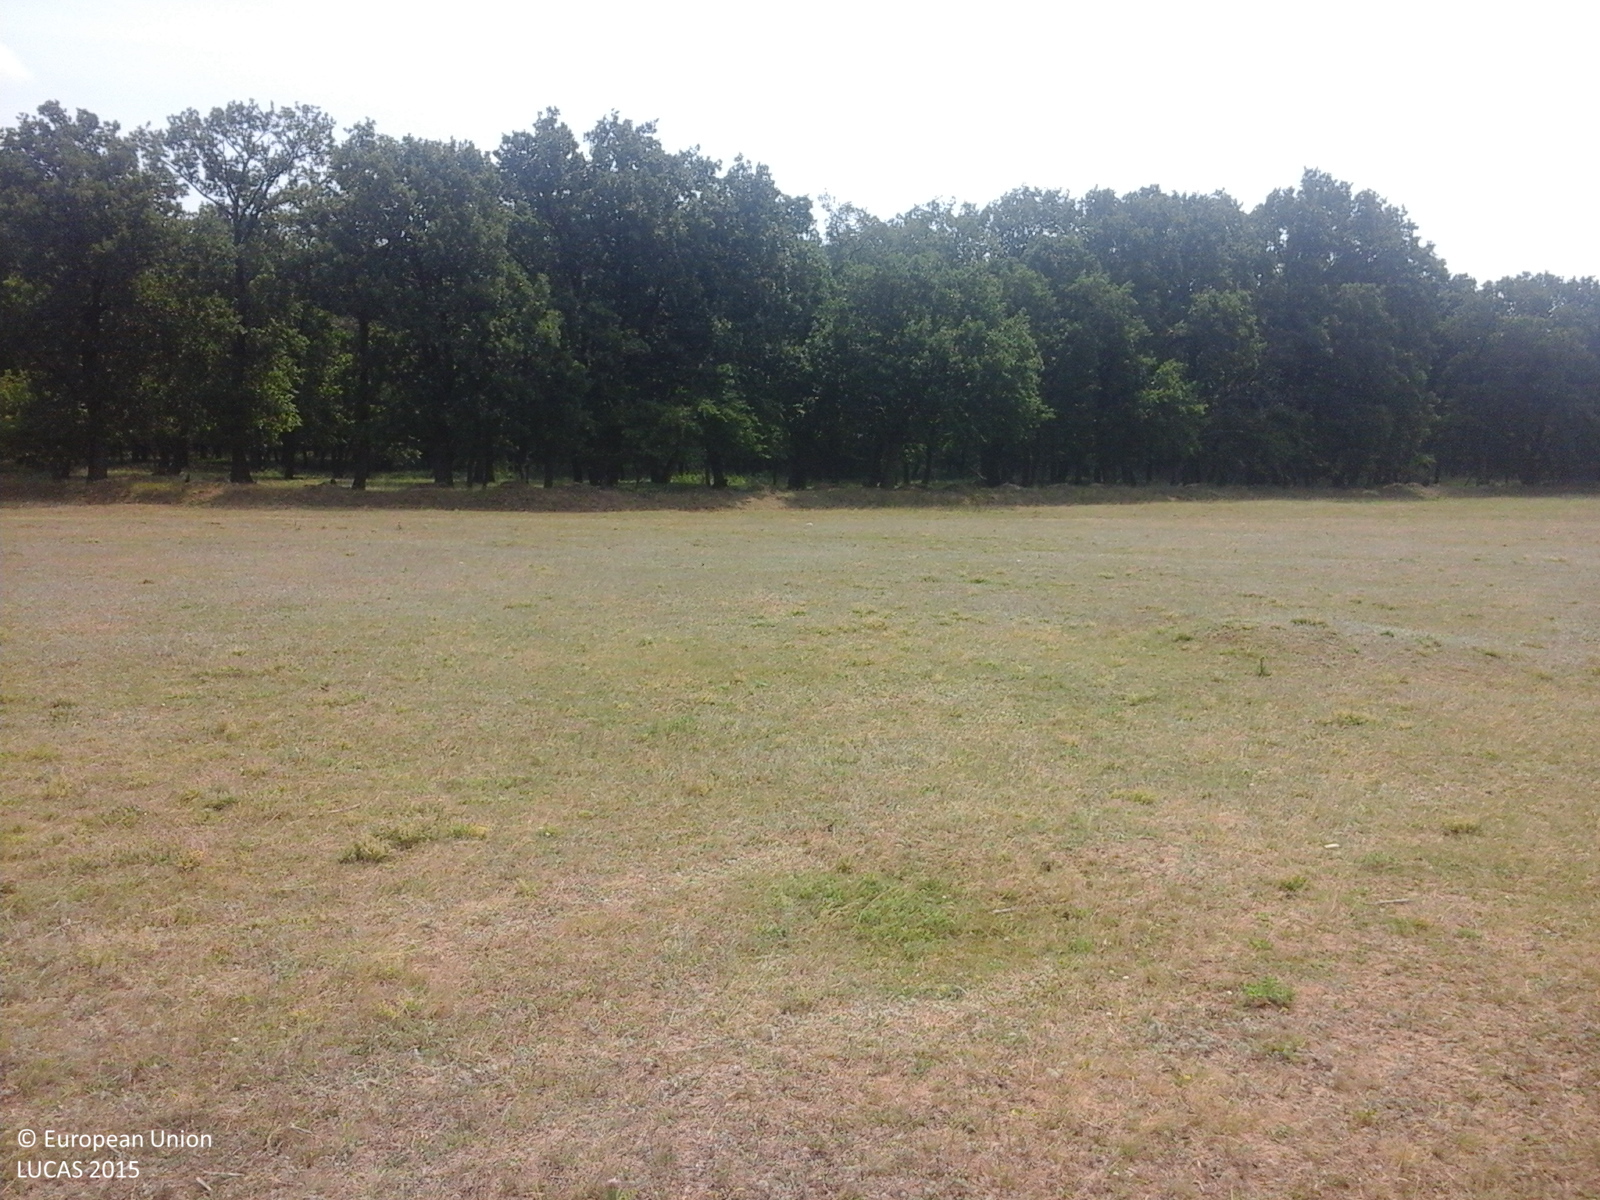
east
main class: Grassland
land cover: Grassland without tree/shrub cover
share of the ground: > 75 %
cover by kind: herbaceous plants 100 %
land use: Agriculture (excluding fallow land and kitchen gardens)
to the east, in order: Grassland without tree/shrub cover; Tracks; Grassland without tree/shrub cover; Ditches and canals; Broadleaved woodland
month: June
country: RO
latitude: 47.3662
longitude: 27.0122
